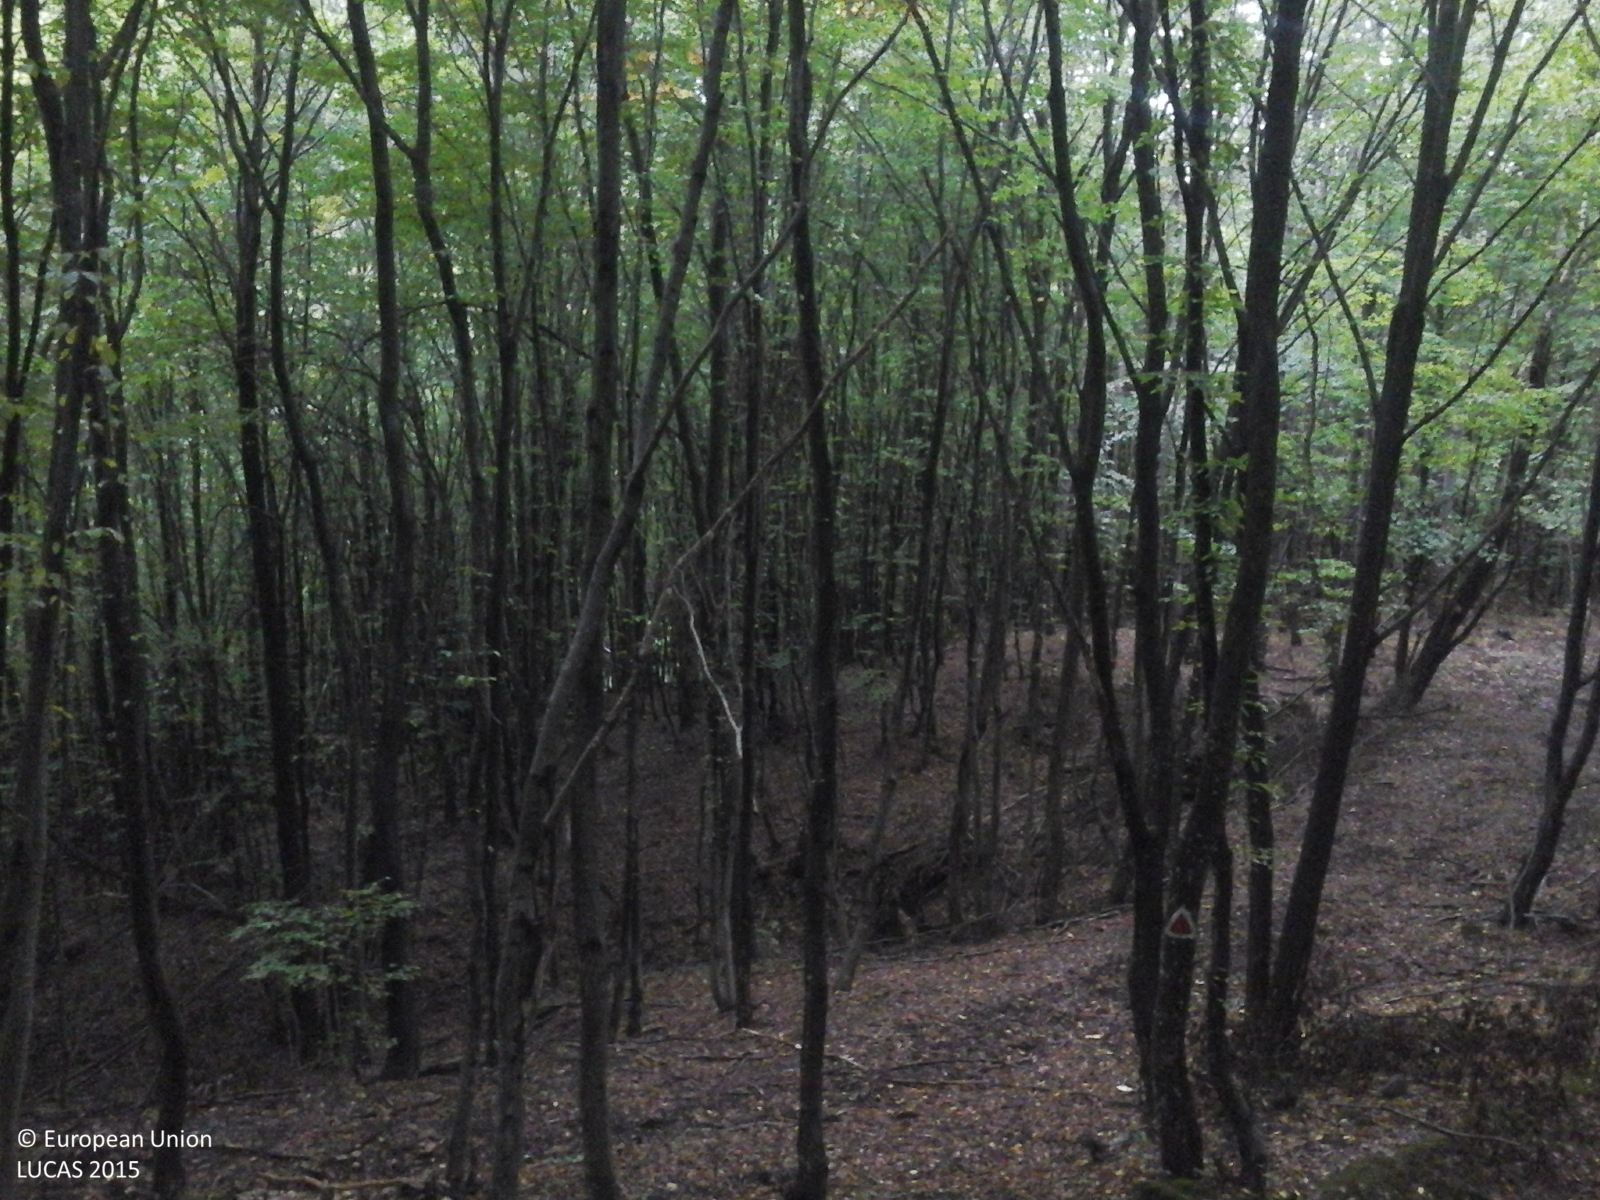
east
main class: Woodland
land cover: Broadleaved woodland
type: mesophytic deciduous forest
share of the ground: > 75 %
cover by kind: broadleaved forest trees 100 %
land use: Forestry
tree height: > 5 m
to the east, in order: Broadleaved woodland; Tracks; Broadleaved woodland; Inland fresh running water; Broadleaved woodland
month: October
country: RO
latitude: 46.2516
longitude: 23.5441
